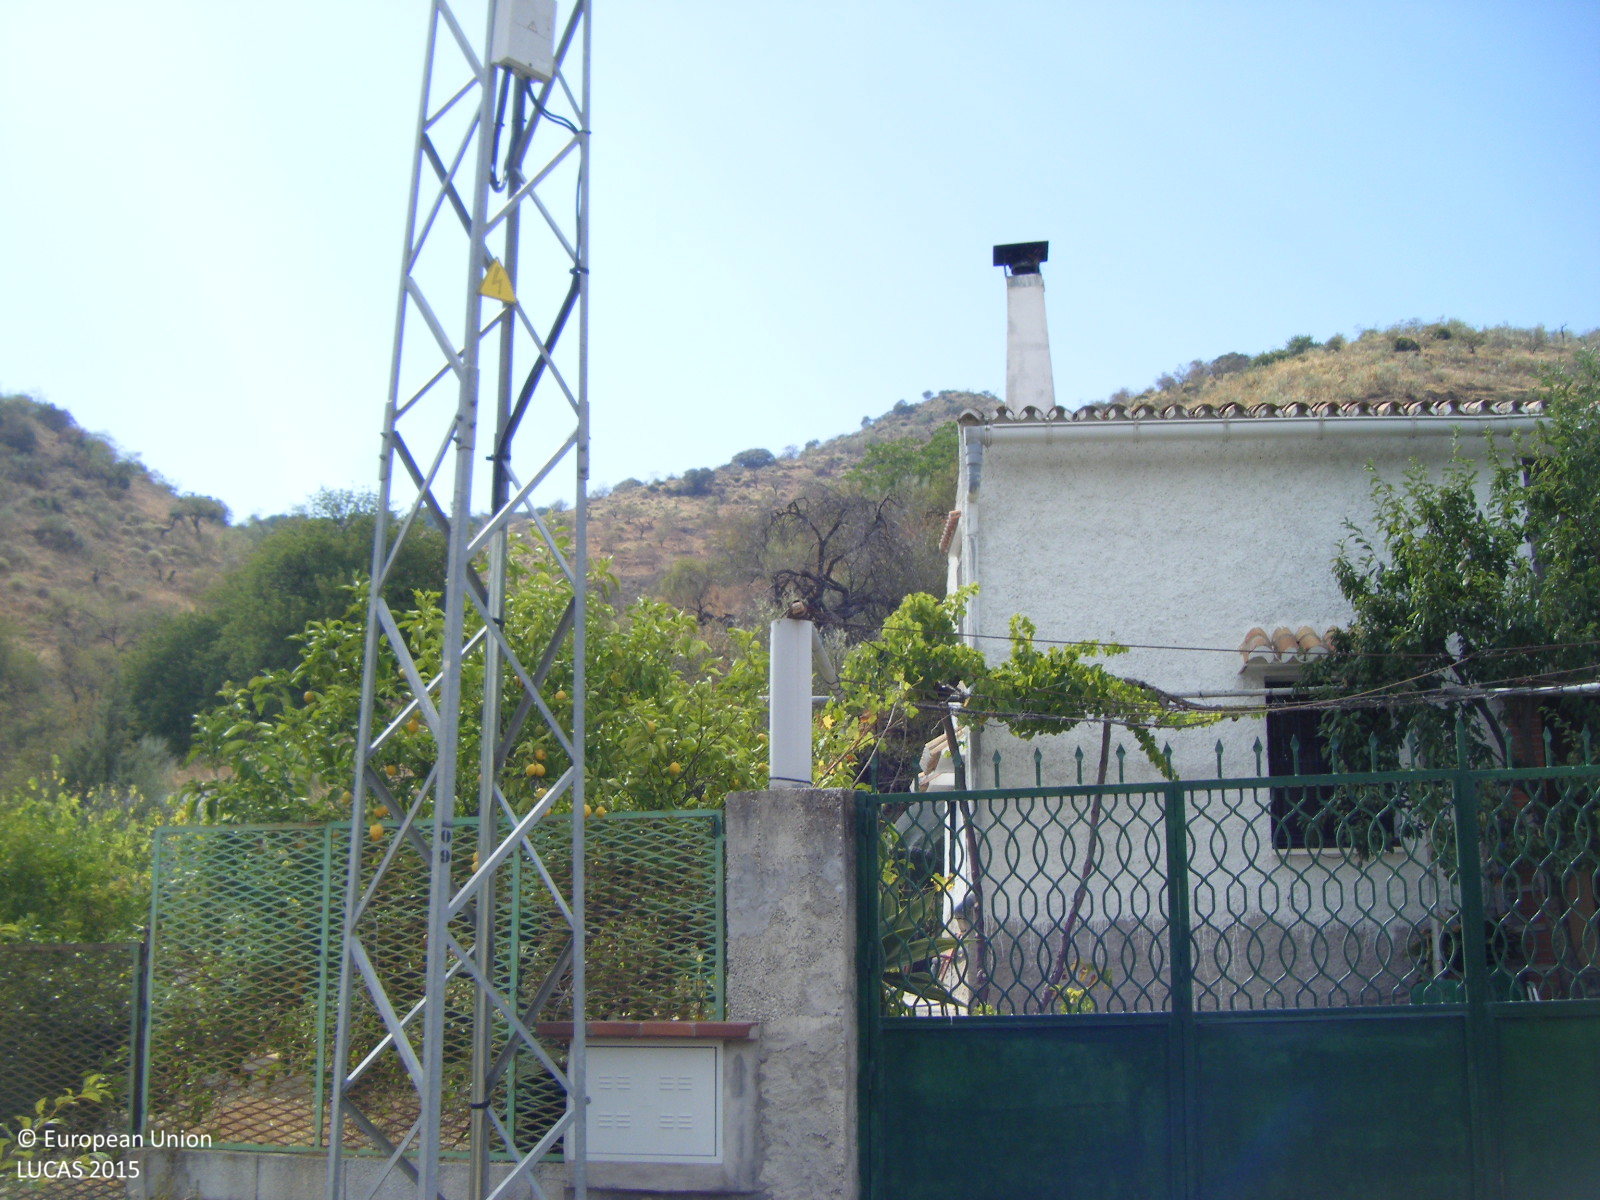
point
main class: Shrubland
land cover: Shrubland without tree cover
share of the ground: > 75 %
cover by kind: shrubs 100 %
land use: Semi-natural and natural areas not in use
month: July
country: ES
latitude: 36.8582
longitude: -4.4503
